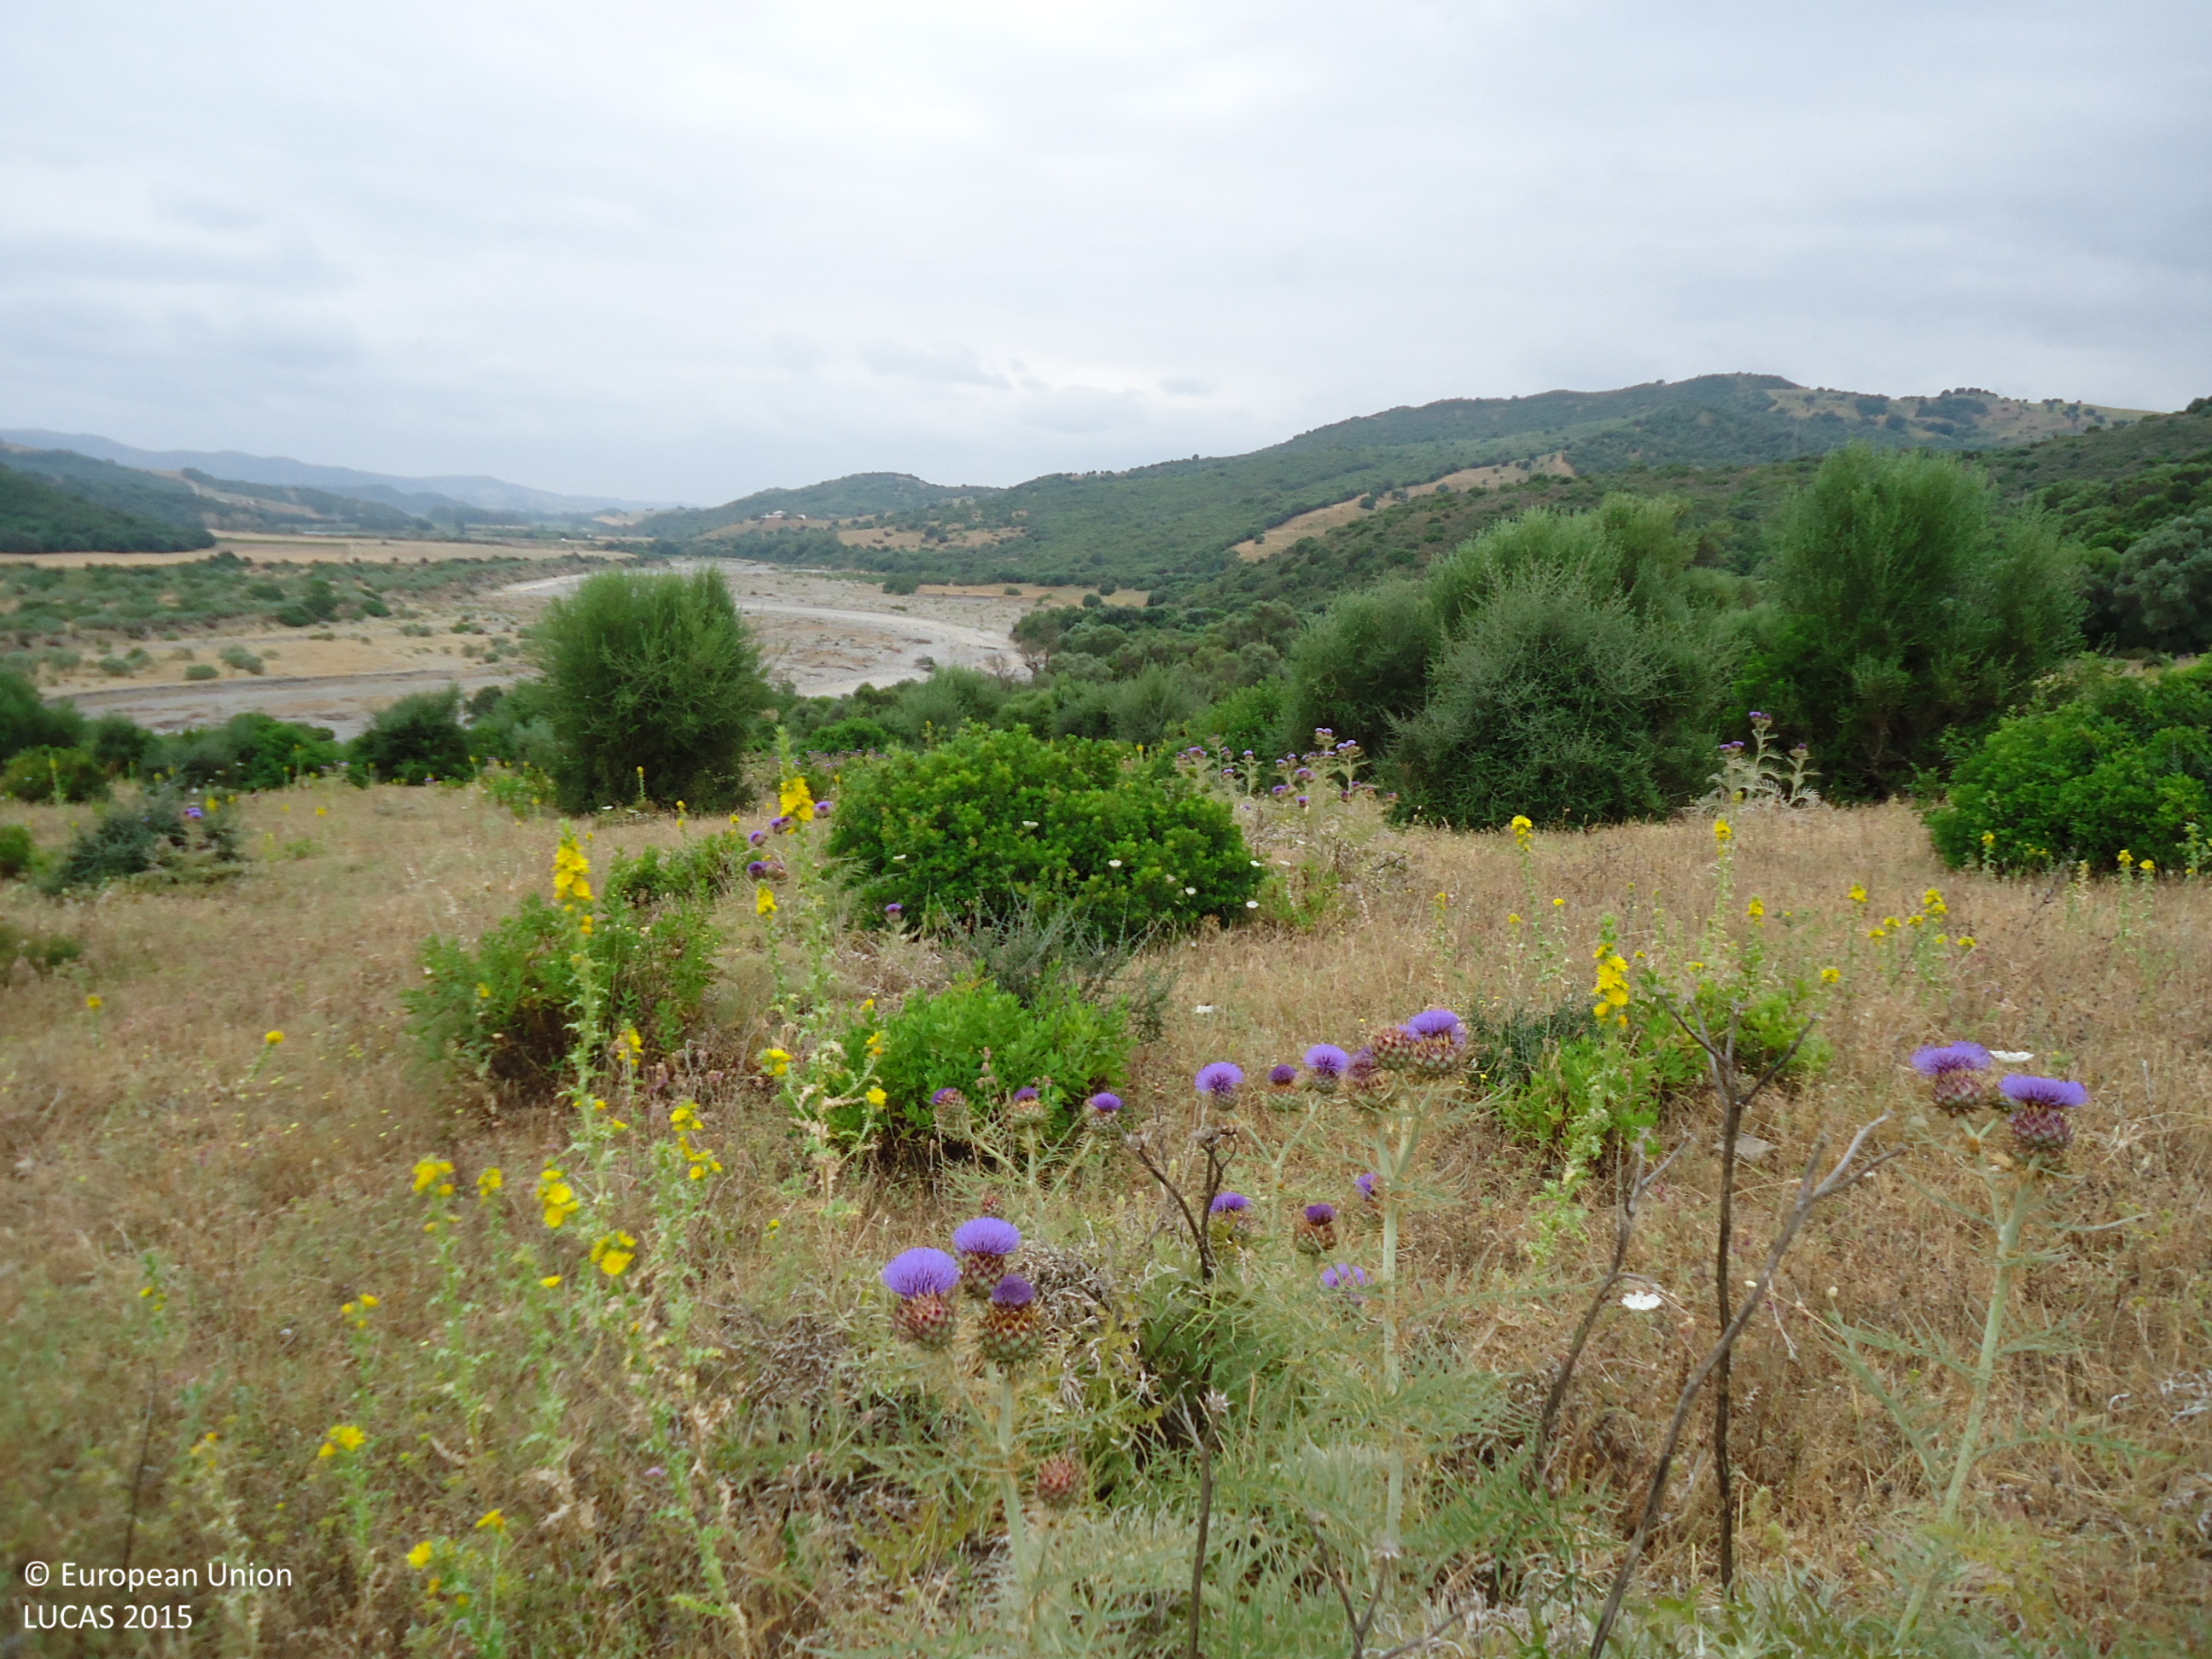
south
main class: Grassland
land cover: Grassland without tree/shrub cover
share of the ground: > 75 %
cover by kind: herbaceous plants 100 %
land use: Agriculture (excluding fallow land and kitchen gardens)
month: June
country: ES
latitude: 36.4582
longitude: -5.3388
